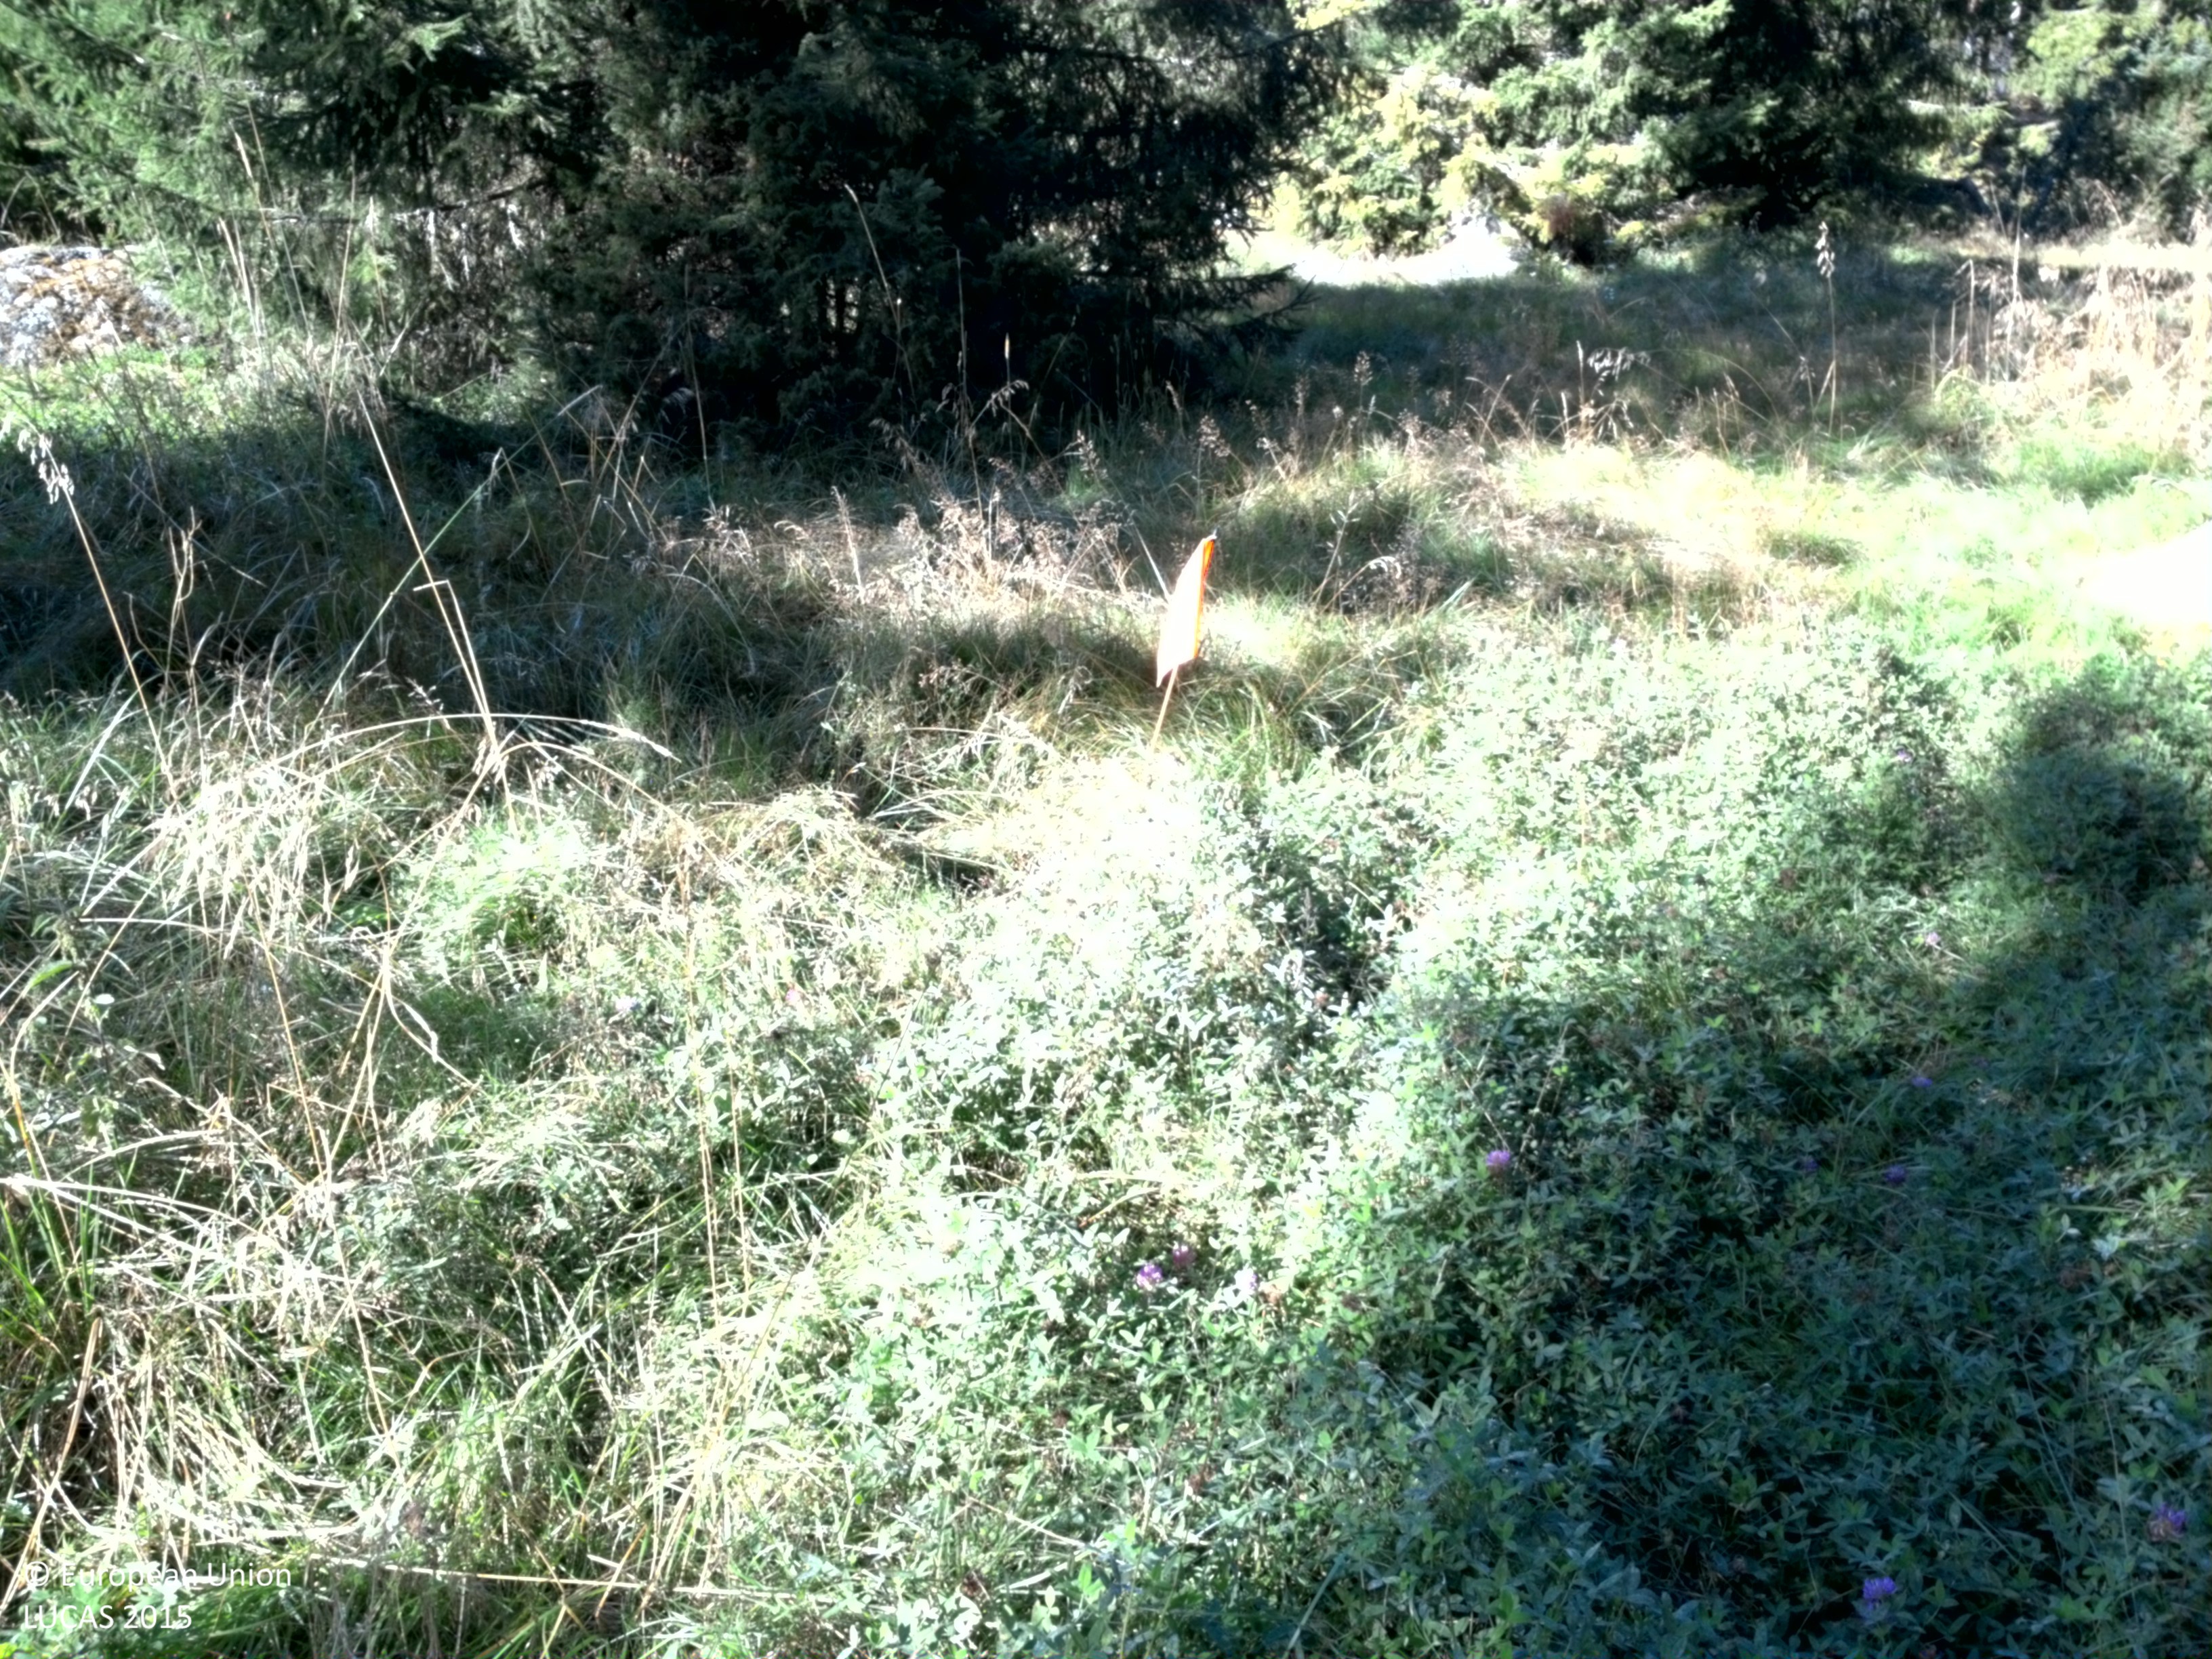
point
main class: Grassland
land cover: Grassland with sparse tree/shrub cover
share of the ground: > 75 %
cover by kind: herbaceous plants 95 %, coniferous forest trees 5 %
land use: Fallow land
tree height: > 5 m
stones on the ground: < 10 %
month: August
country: SE
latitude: 59.8582
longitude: 17.7613
